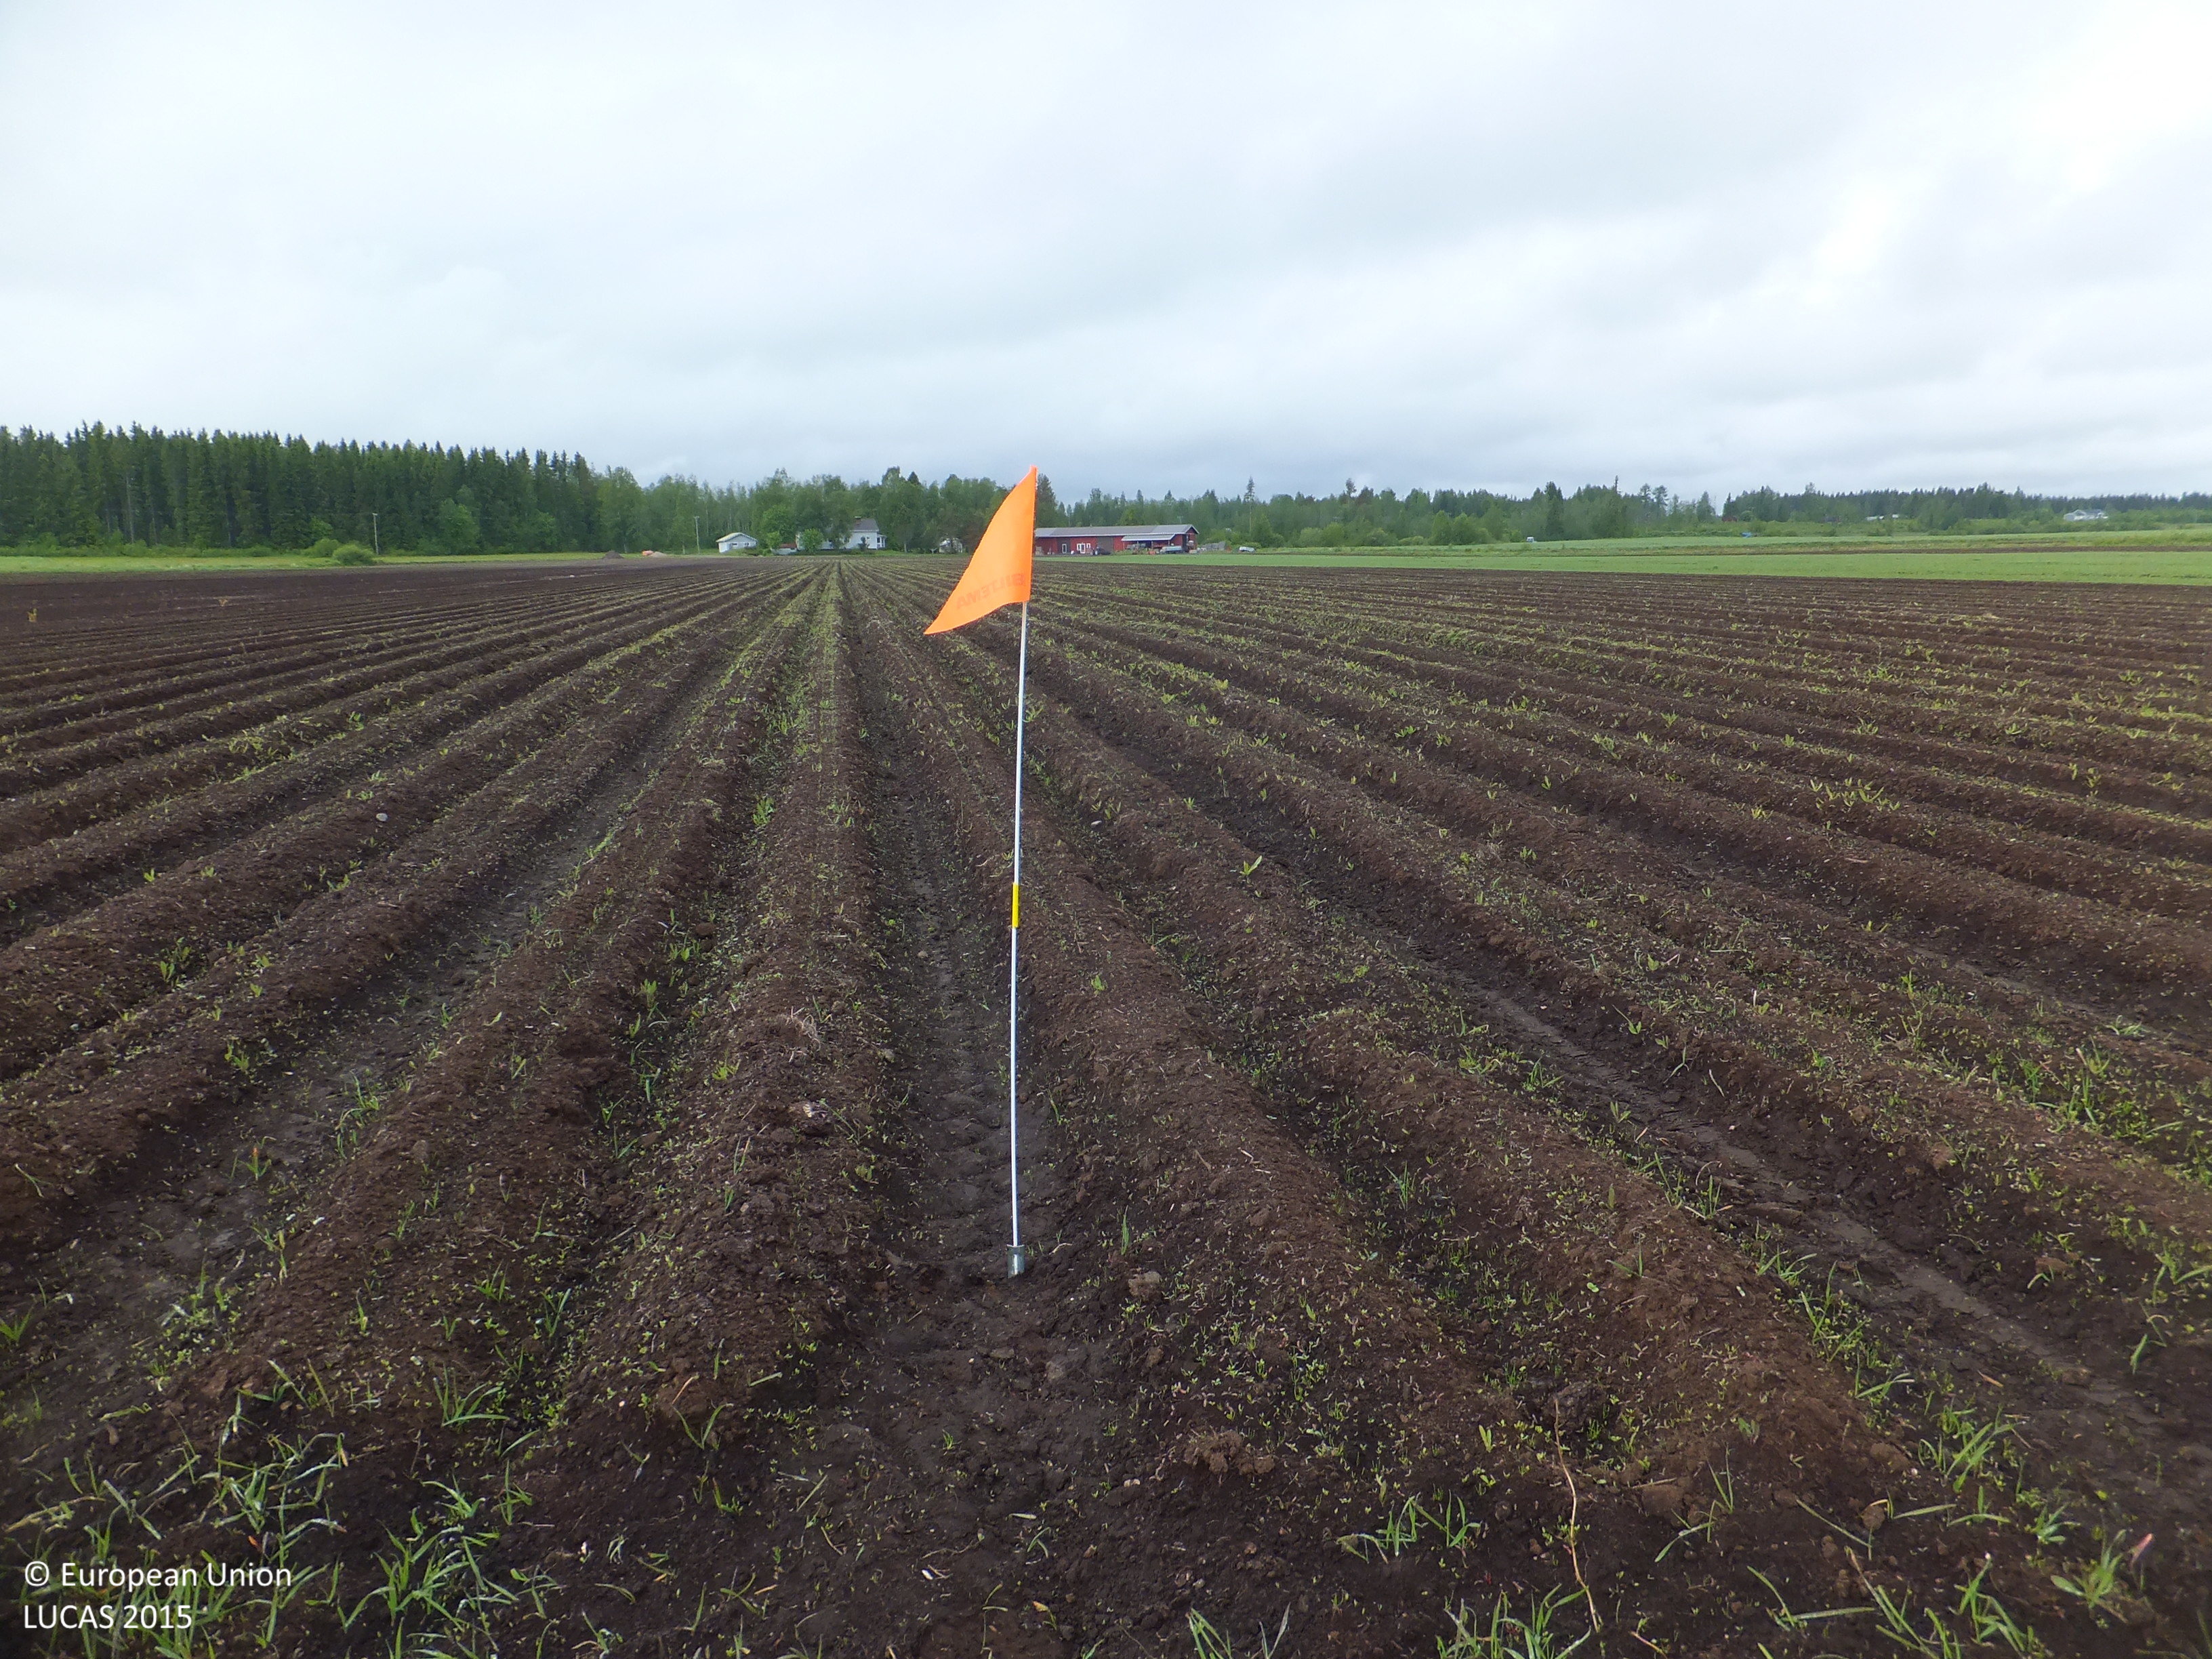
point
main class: Cropland
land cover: Maize
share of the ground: < 10 %
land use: Agriculture (excluding fallow land and kitchen gardens)
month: June
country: FI
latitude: 63.5792
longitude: 24.8926
